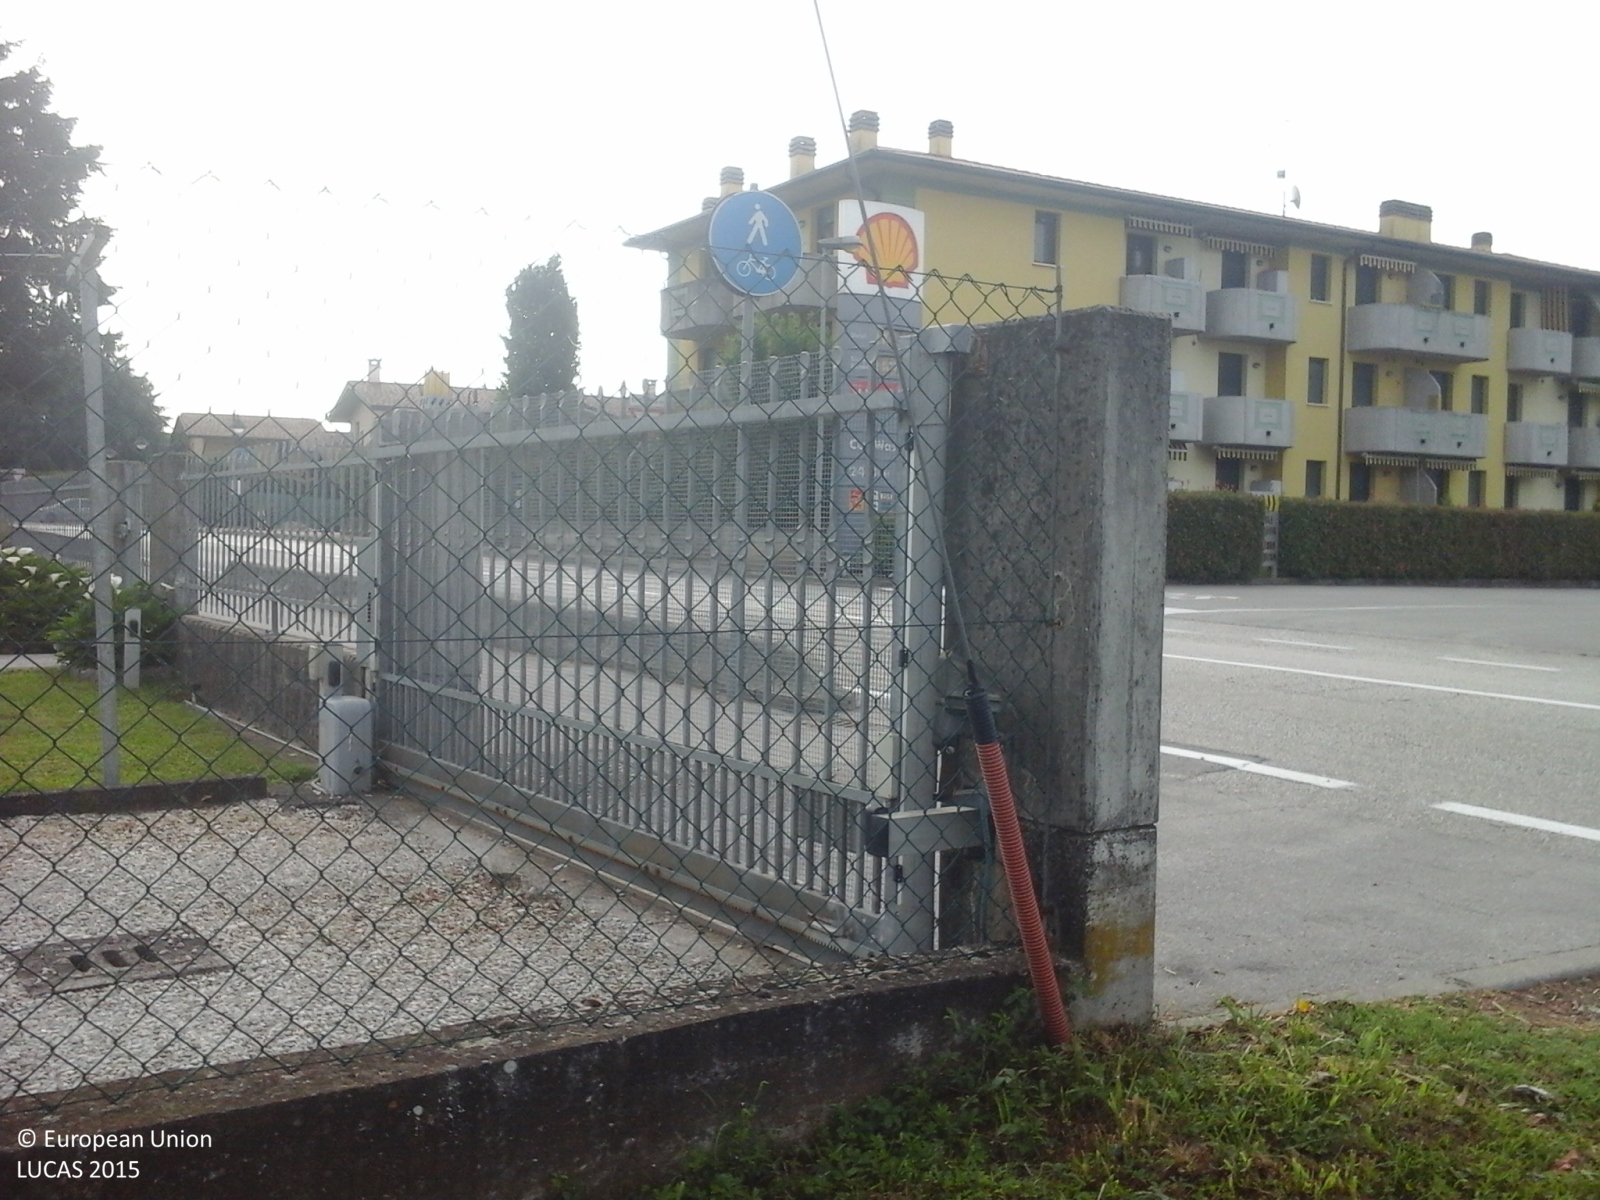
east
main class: Grassland
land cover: Grassland without tree/shrub cover
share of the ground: > 75 %
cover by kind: herbaceous plants 100 %
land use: Agriculture (excluding fallow land and kitchen gardens)
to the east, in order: Grassland without tree/shrub cover; Artificial constructions in urban areas
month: May
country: IT
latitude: 45.4899
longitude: 11.7501
